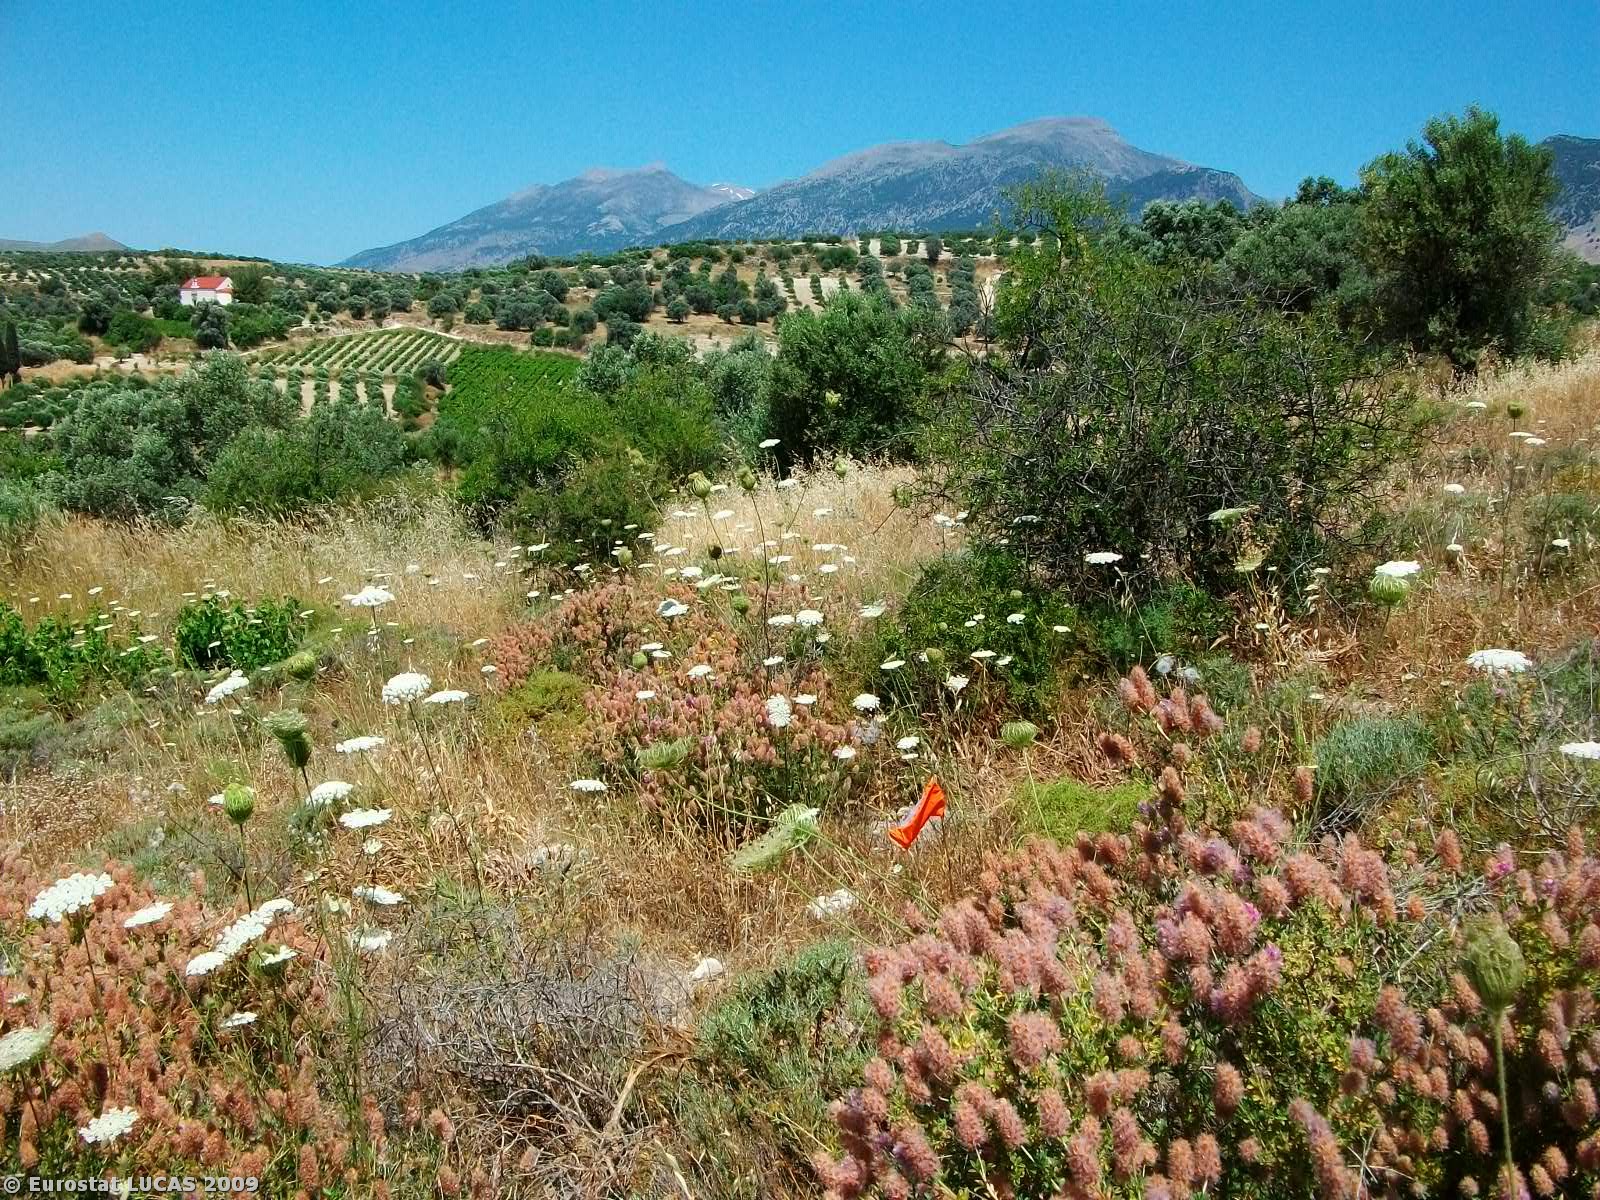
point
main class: Shrubland
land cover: Shrubland with sparse tree cover
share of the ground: > 75 %
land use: Unused
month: June
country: GR
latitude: 35.1047
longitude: 24.9397
